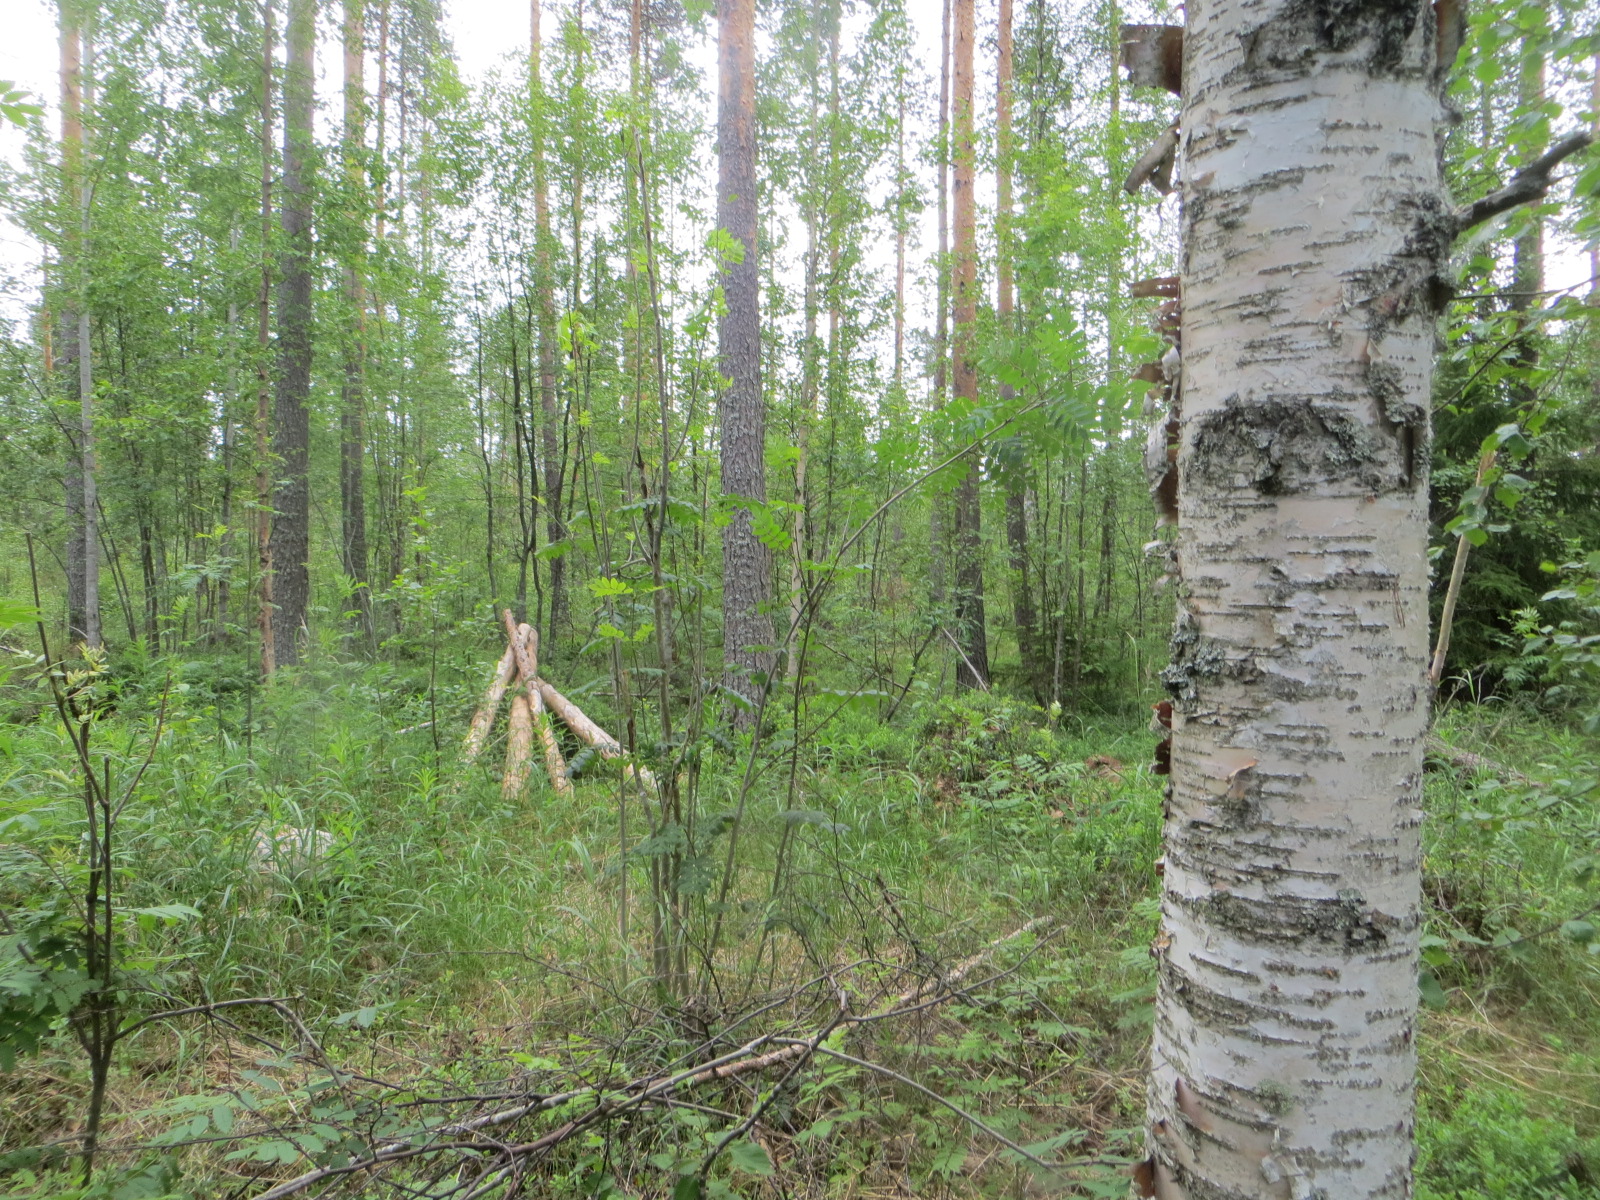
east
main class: Woodland
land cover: Other mixed woodland
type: boreal forest
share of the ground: 50 - 75 %
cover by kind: shrubs 45 %, coniferous forest trees 35 %, broadleaved forest trees 20 %
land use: Forestry
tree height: > 5 m
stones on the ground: 10 - 25 %
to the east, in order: Other mixed woodland; Pine dominated coniferous woodland; Broadleaved woodland; Inland fresh running water
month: July
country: FI
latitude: 65.7146
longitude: 25.1682
